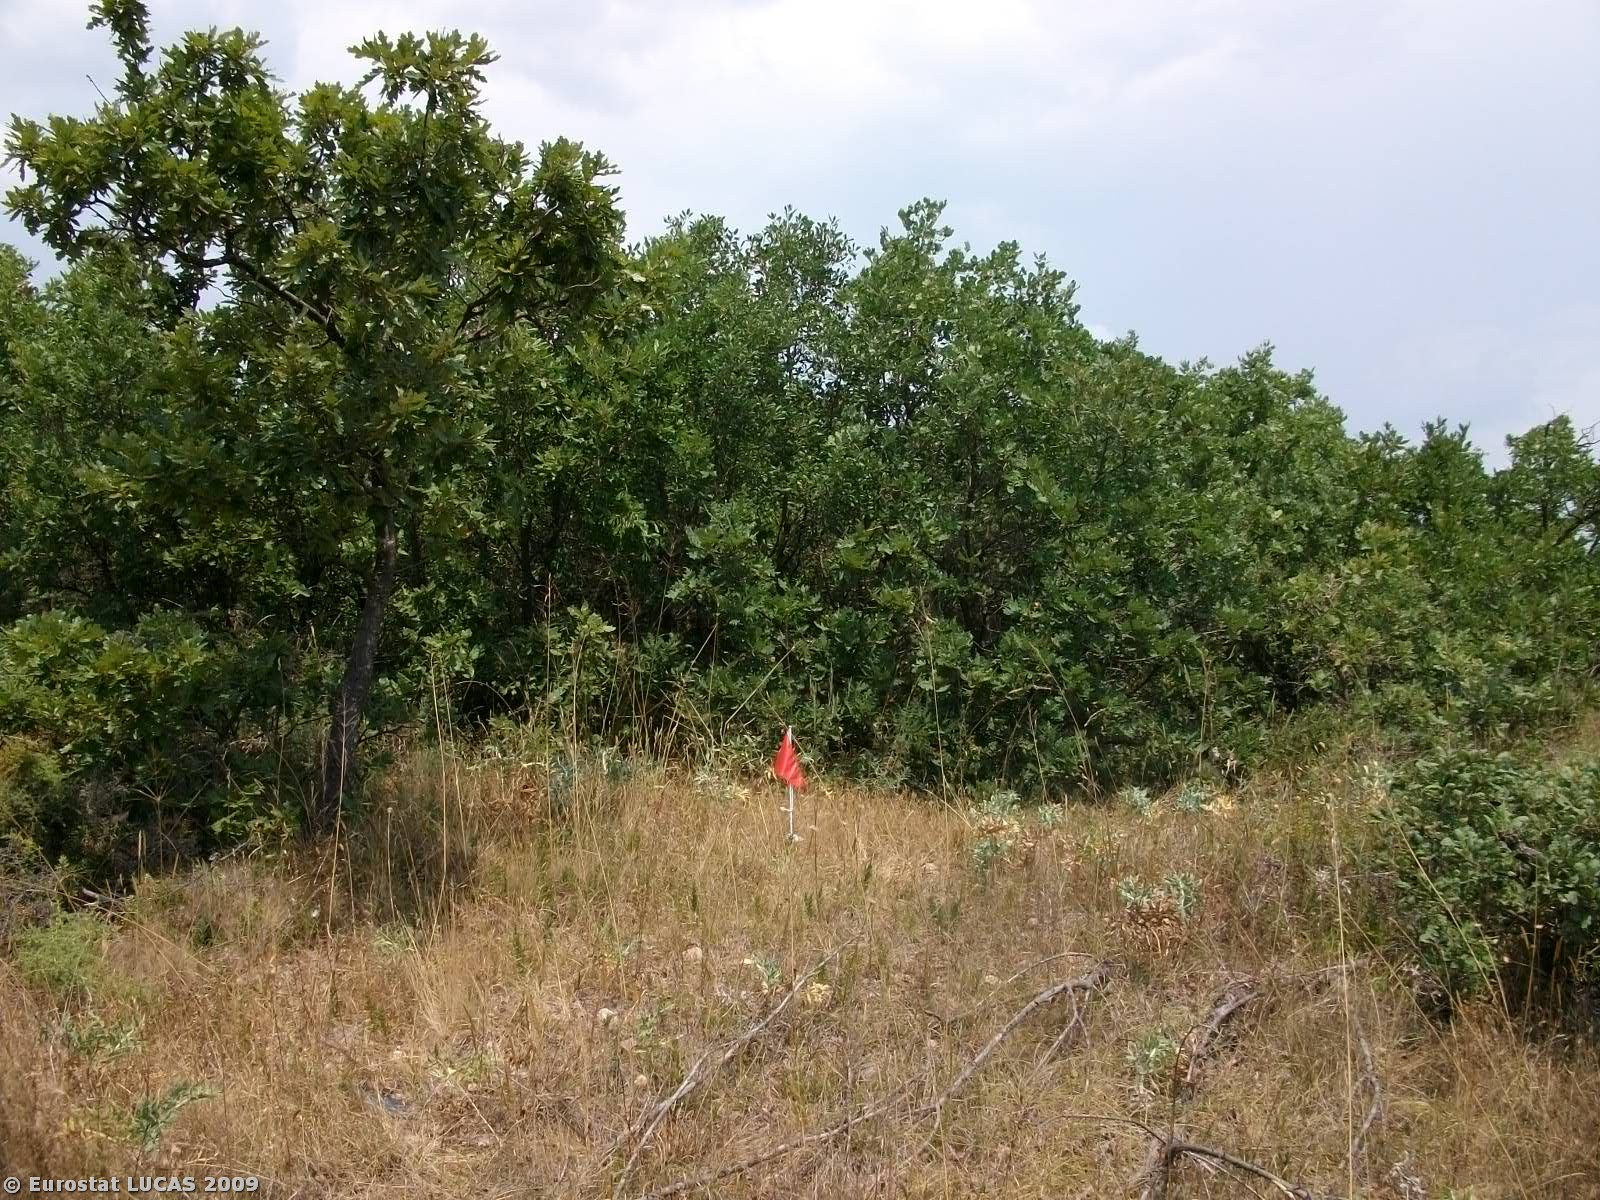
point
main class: Shrubland
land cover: Shrubland with sparse tree cover
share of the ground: 25 - 50 %
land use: Unused
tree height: < 5 m
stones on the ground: 25 - 50 %
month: July
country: GR
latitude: 40.9520
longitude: 26.2092
